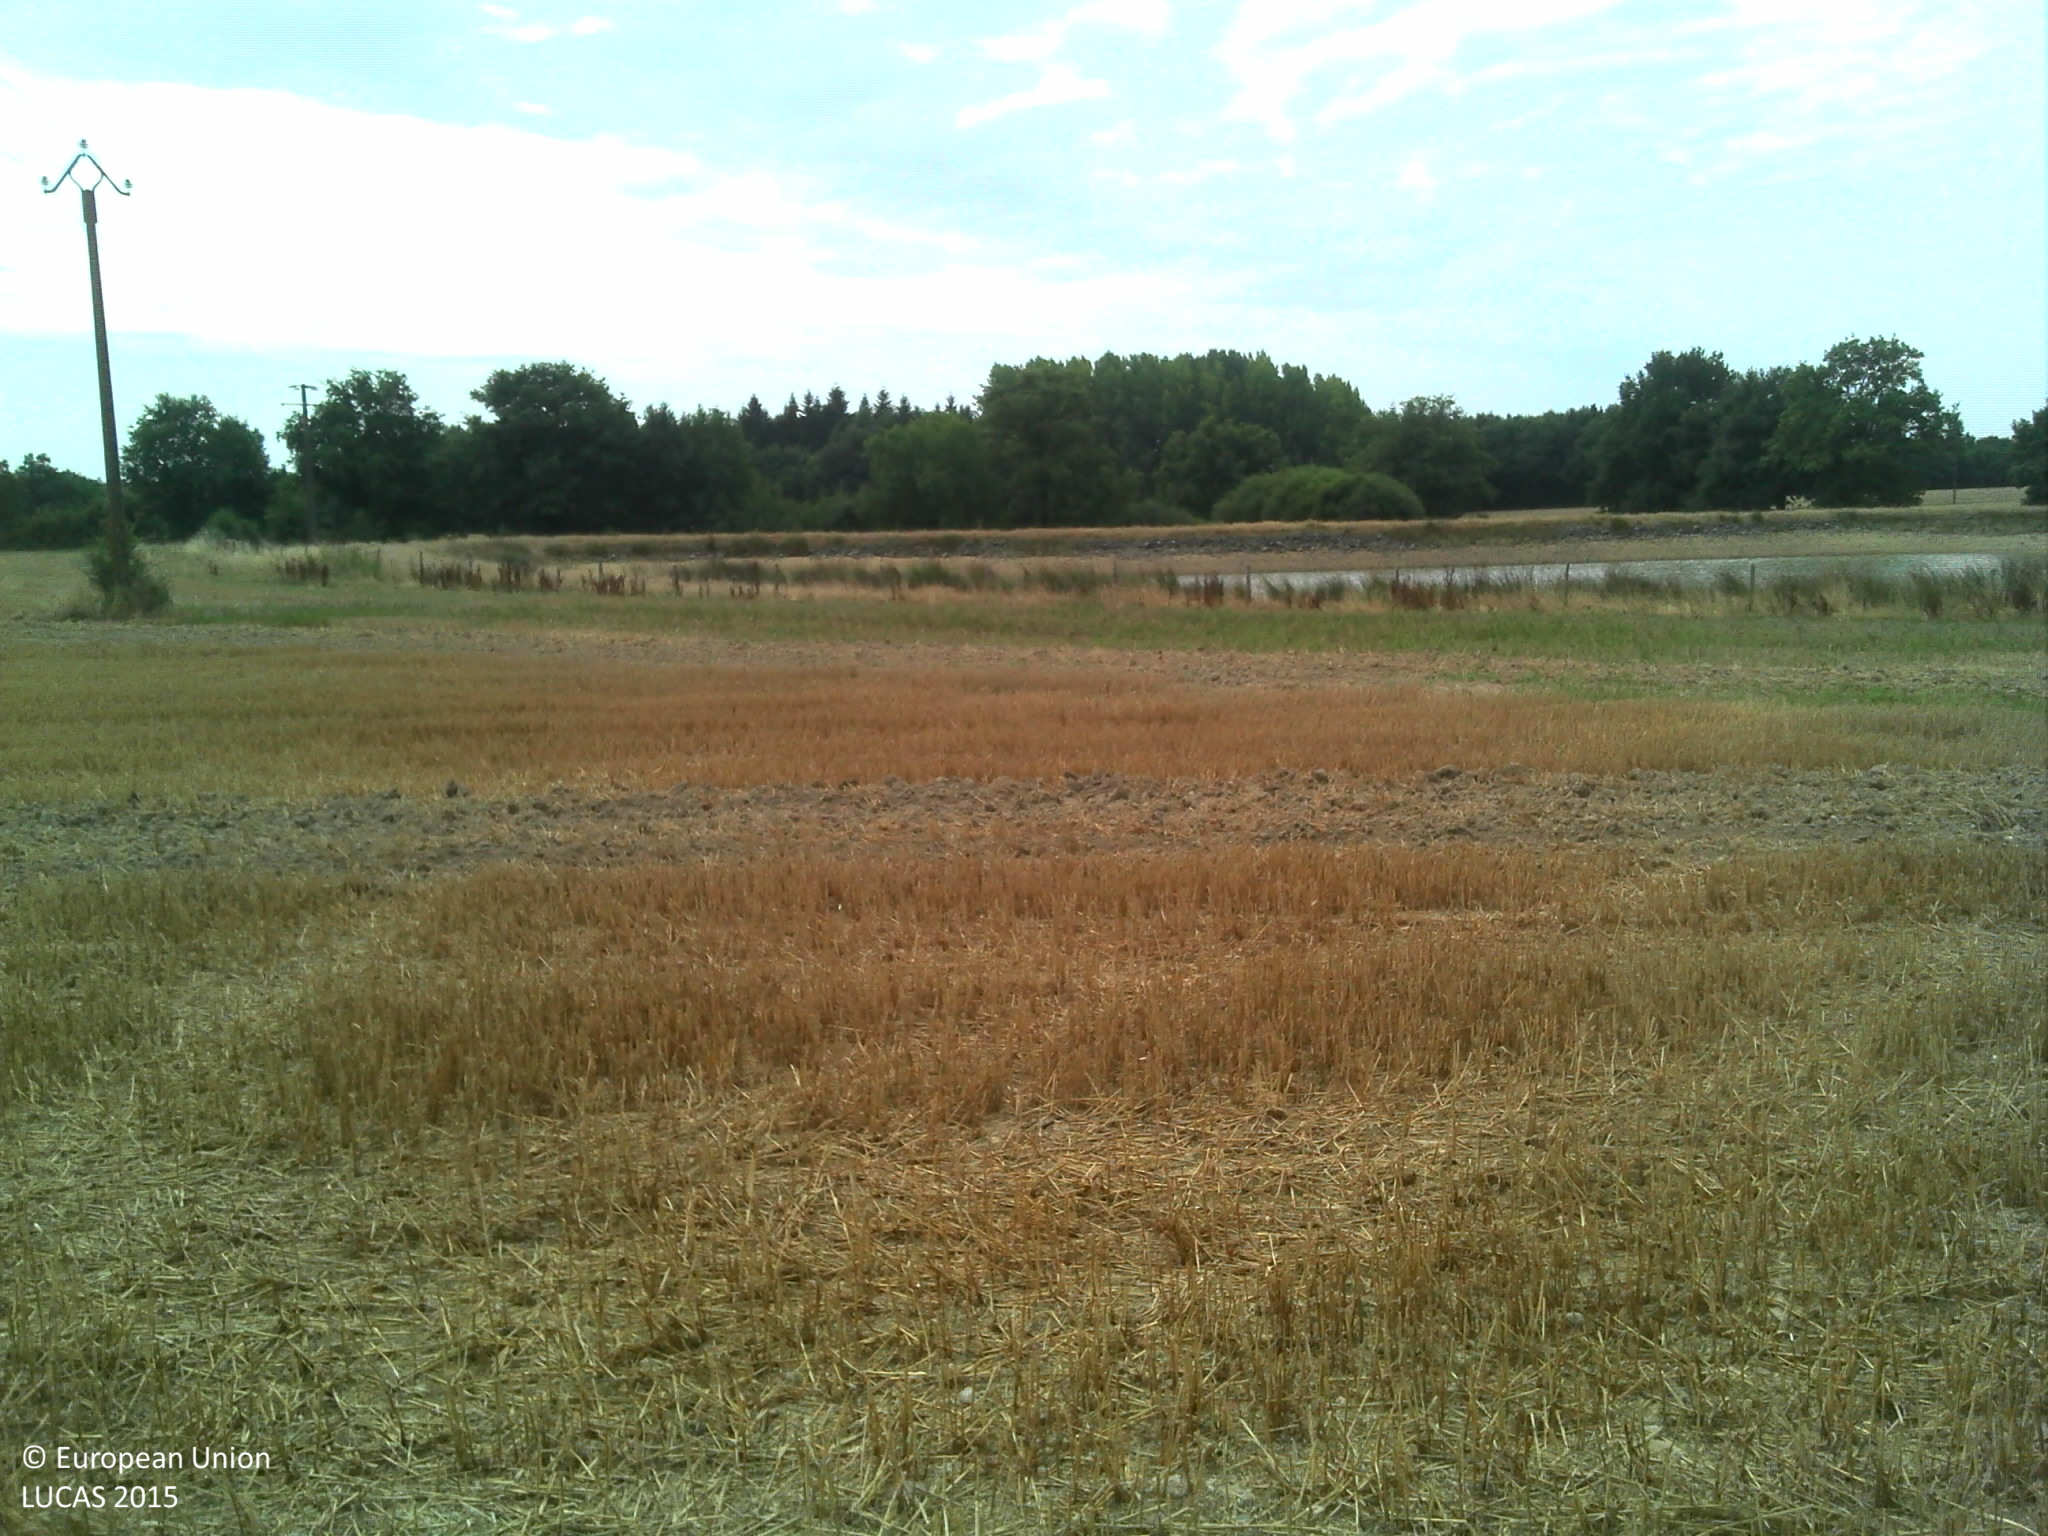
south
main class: Cropland
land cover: Barley
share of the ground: > 75 %
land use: Agriculture (excluding fallow land and kitchen gardens)
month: August
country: FR
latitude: 46.6918
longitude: -1.1626
